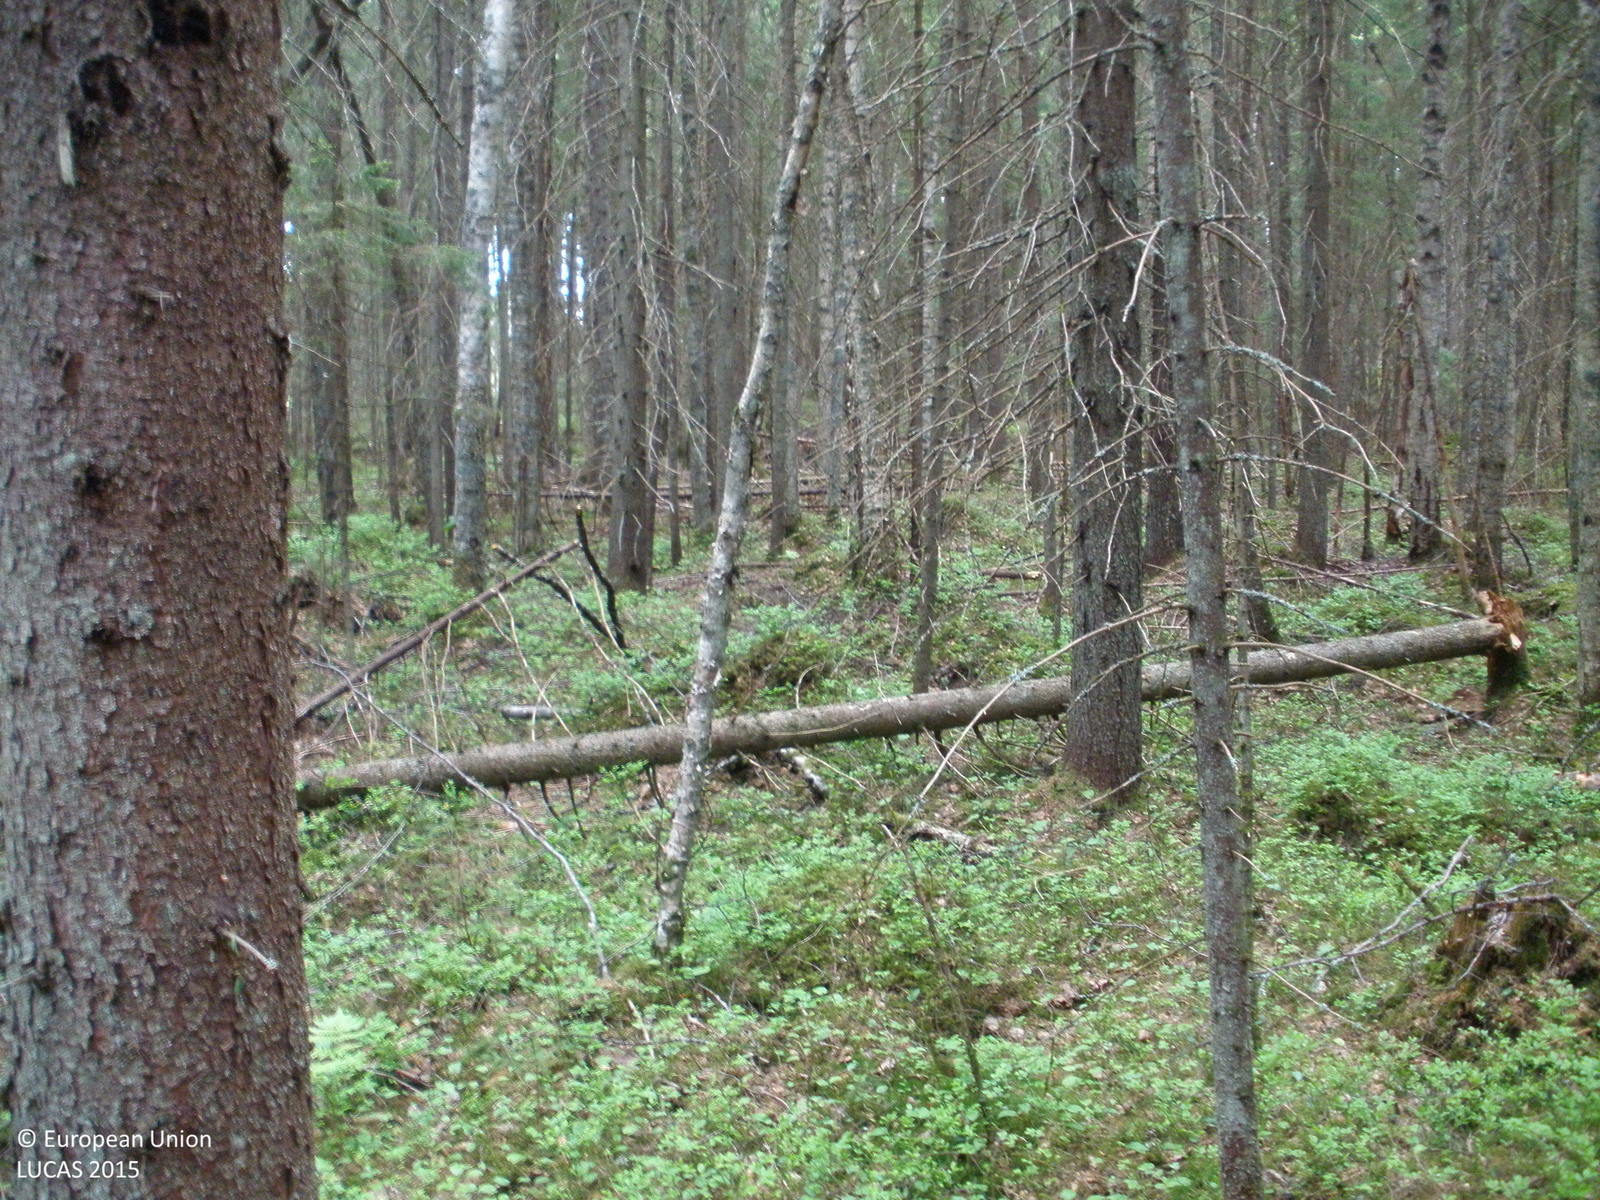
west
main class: Woodland
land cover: Spruce dominated mixed woodland
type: boreal forest
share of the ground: > 75 %
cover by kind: coniferous forest trees 65 %, broadleaved forest trees 25 %, shrubs 5 %, herbaceous plants 5 %
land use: Forestry
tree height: > 5 m
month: June
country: FI
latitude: 60.7234
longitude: 24.0084
